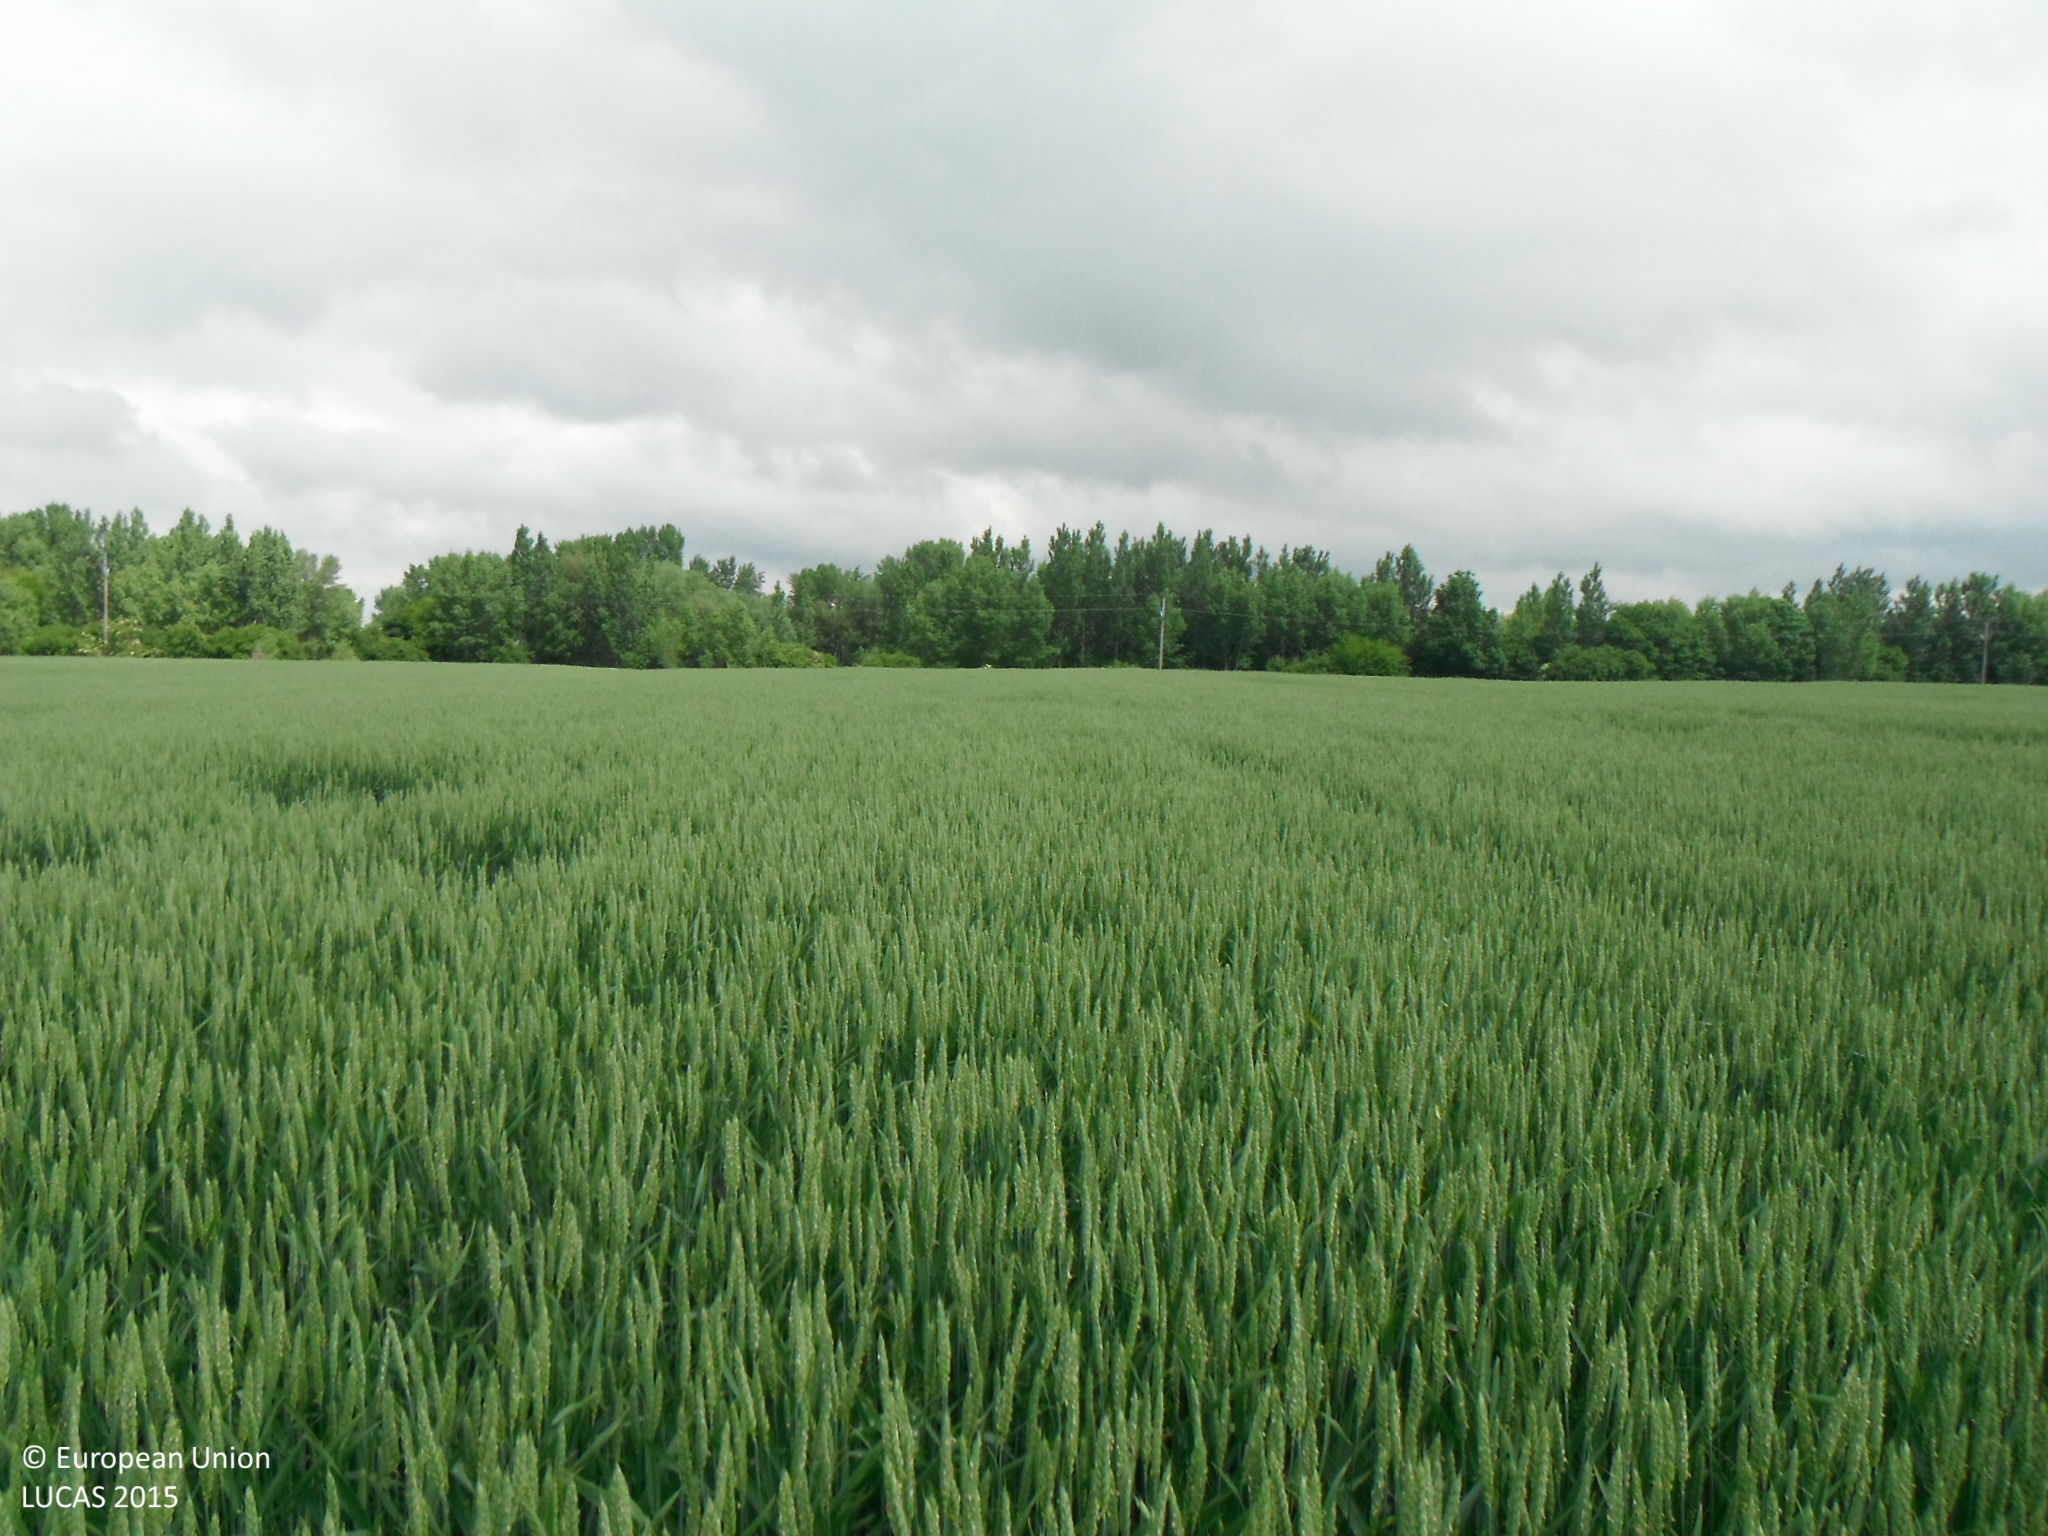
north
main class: Cropland
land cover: Common wheat
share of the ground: > 75 %
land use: Agriculture (excluding fallow land and kitchen gardens)
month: May
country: SK
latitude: 48.1528
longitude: 18.2003
